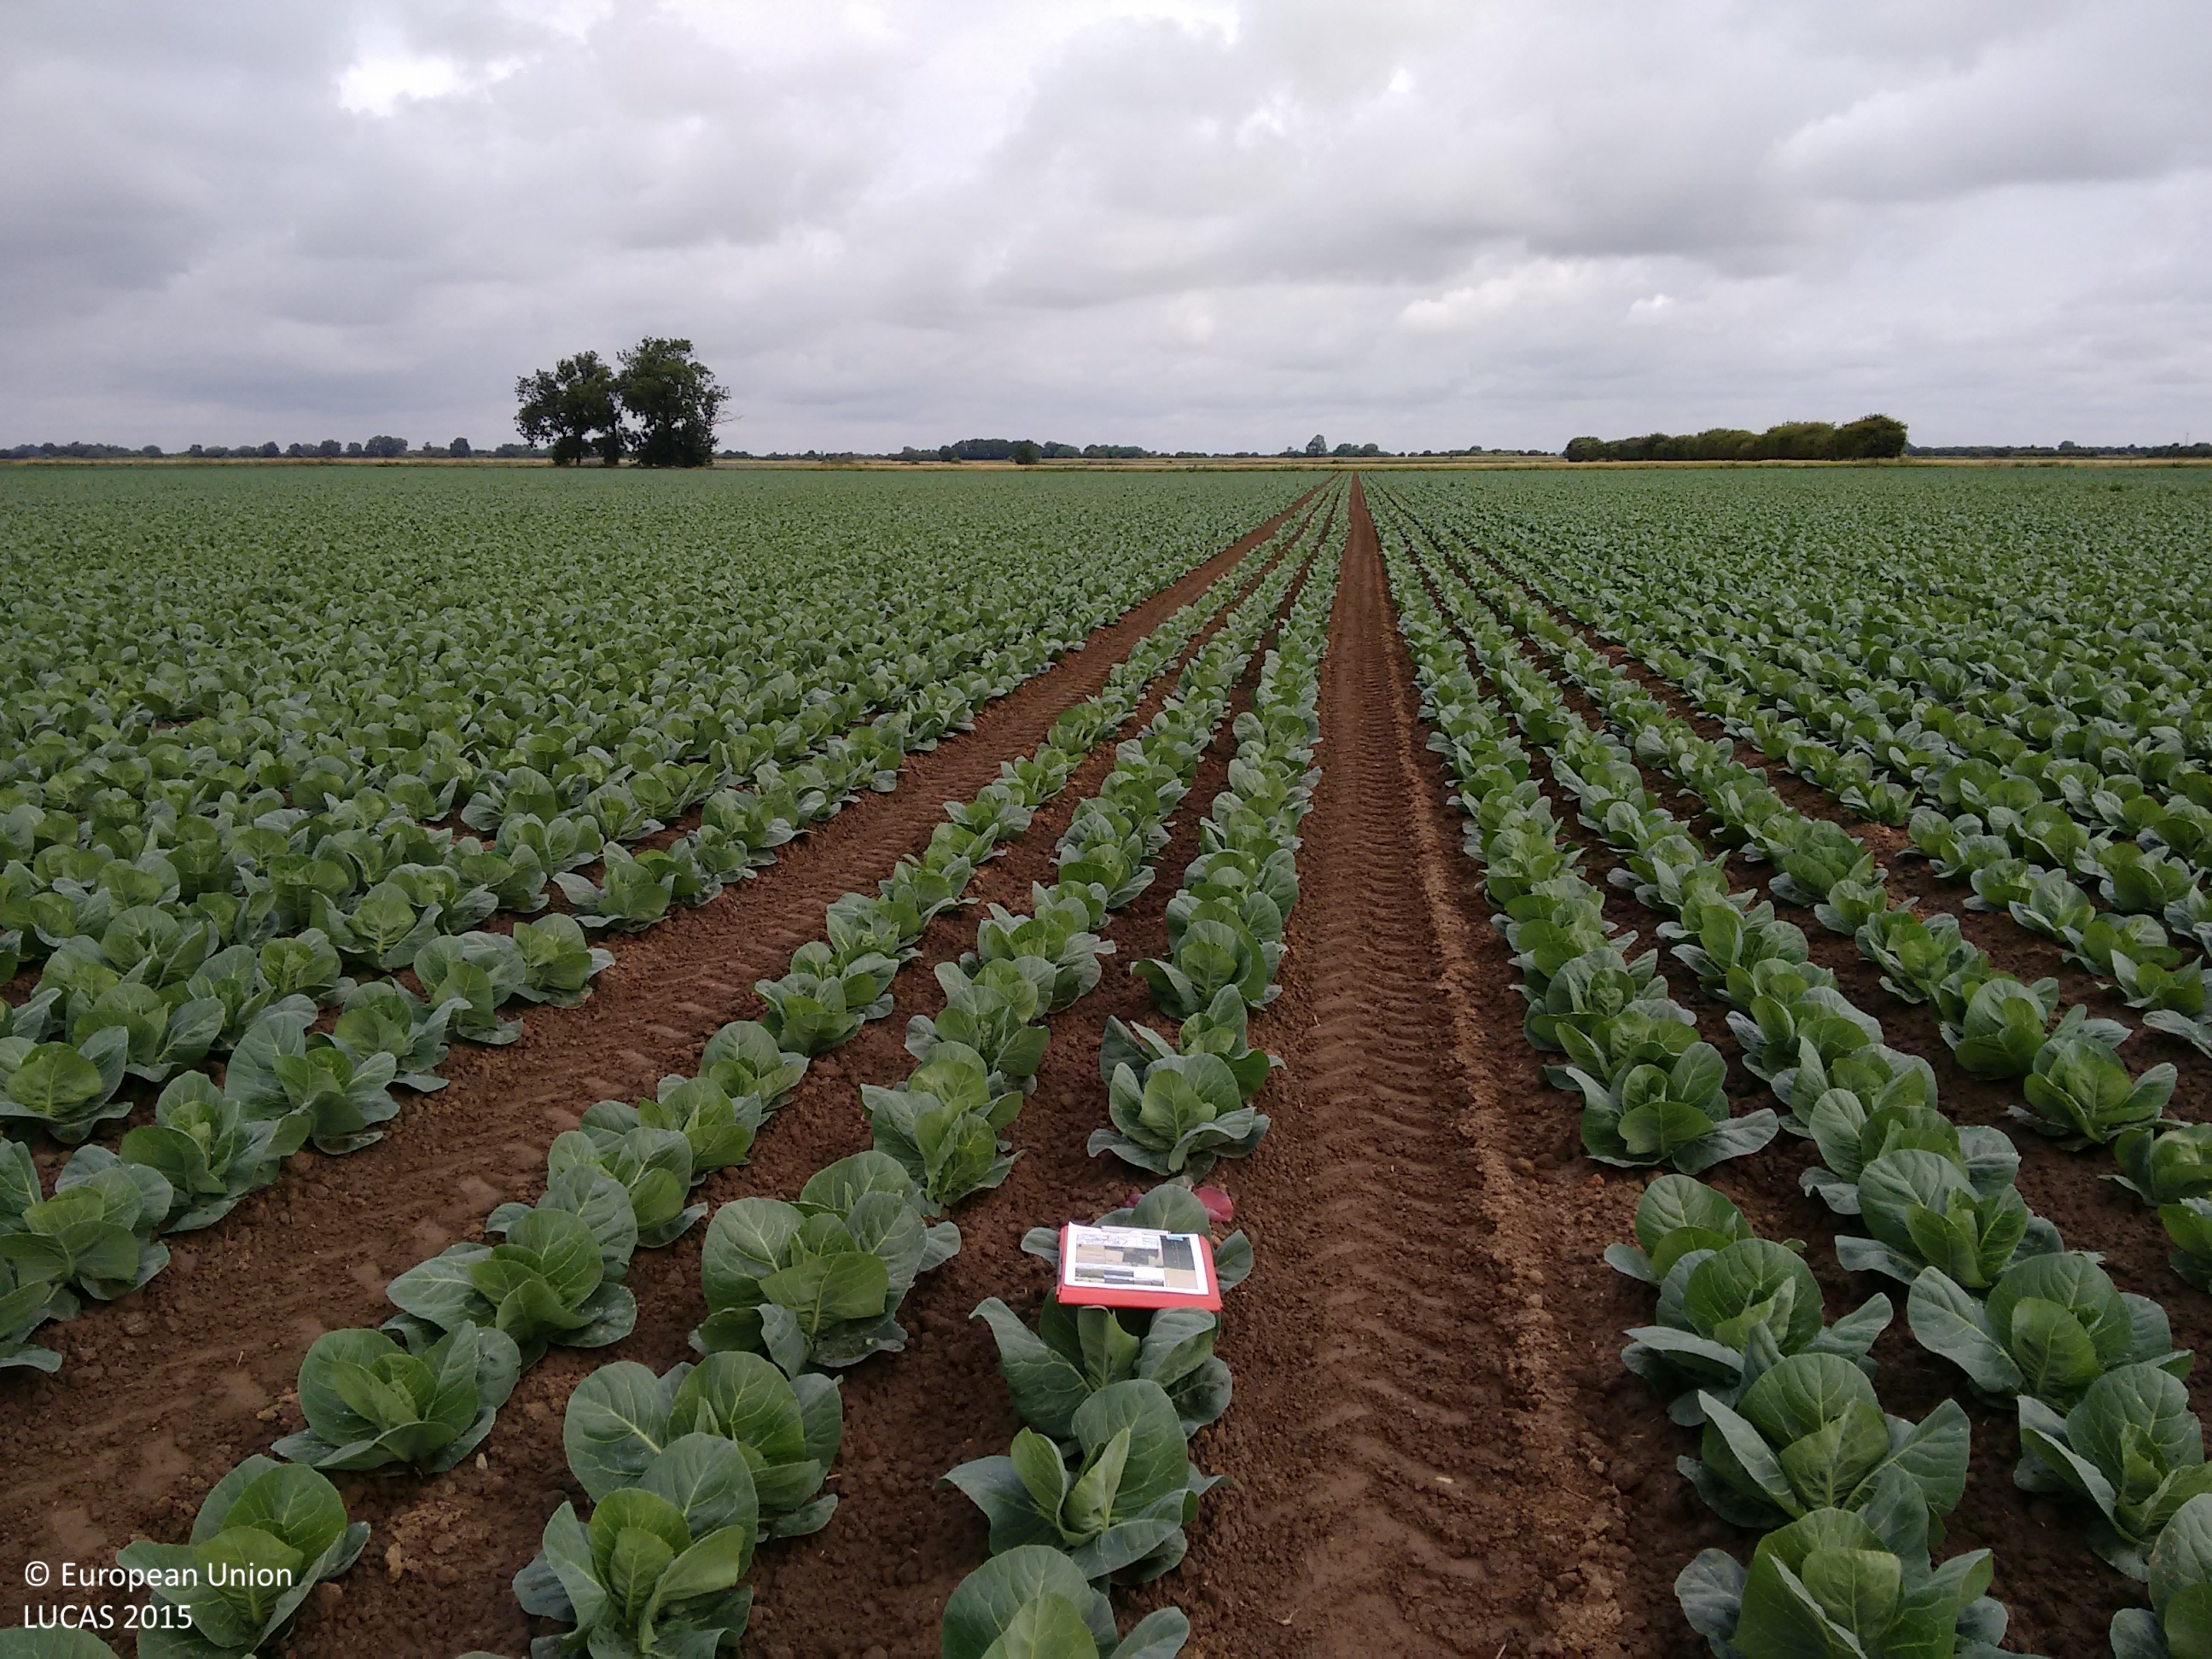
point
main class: Cropland
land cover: Other fresh vegetables
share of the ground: 50 - 75 %
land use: Agriculture (excluding fallow land and kitchen gardens)
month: July
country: GB
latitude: 52.9975
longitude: -0.0905
